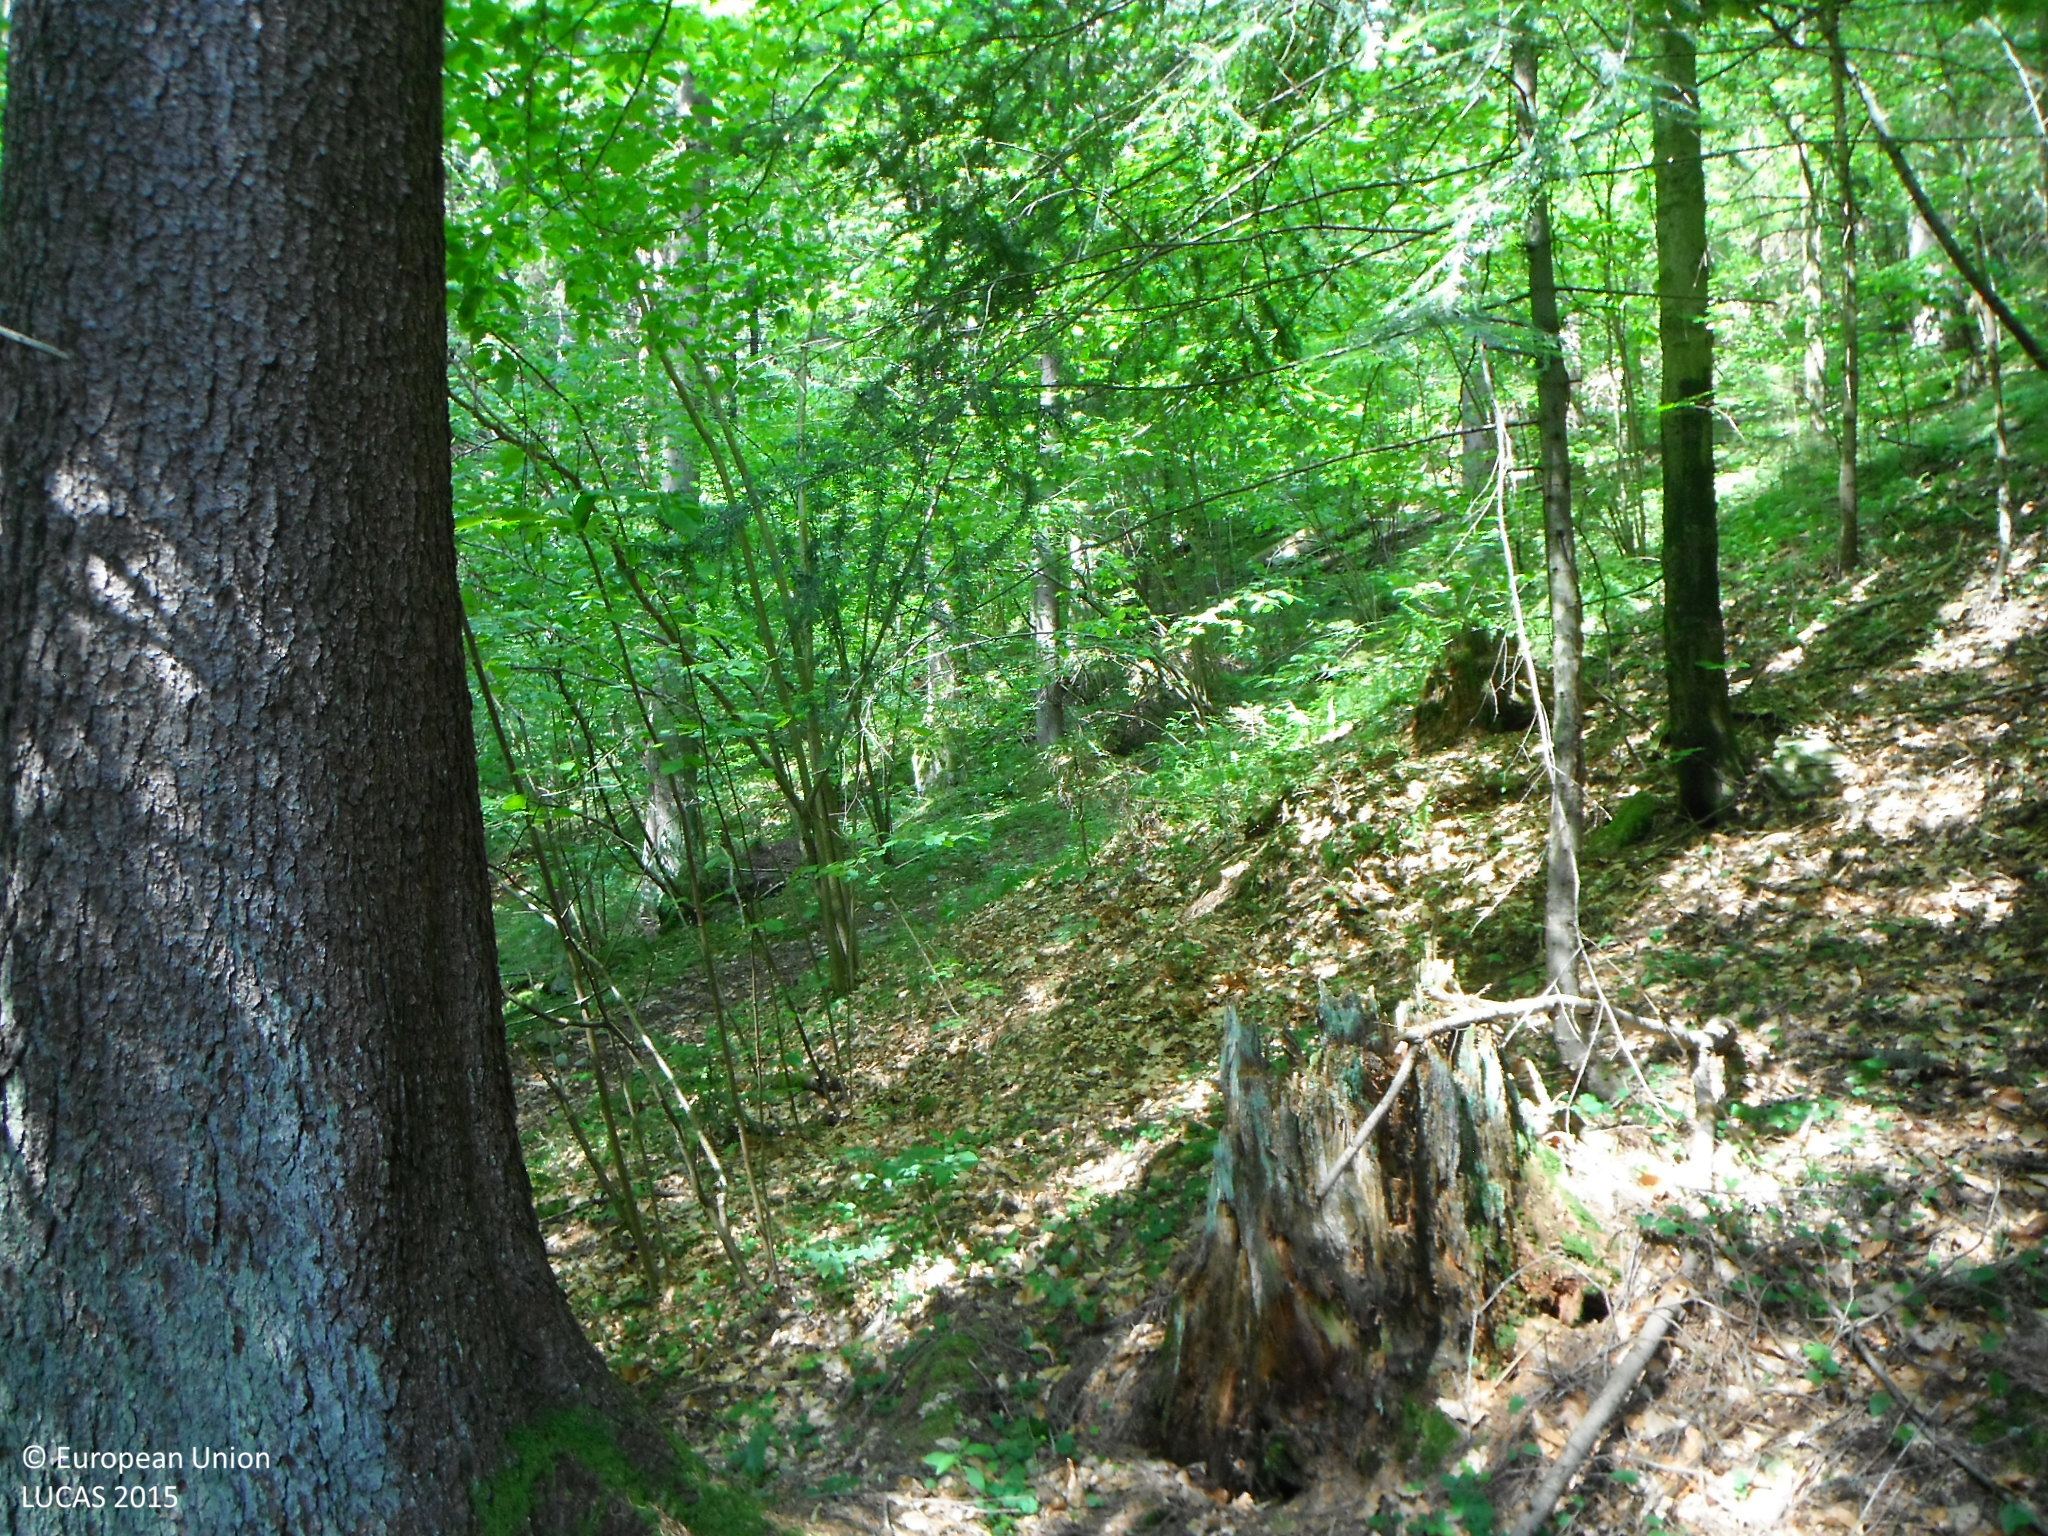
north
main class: Woodland
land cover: Spruce dominated coniferous woodland
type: alpine coniferous forest
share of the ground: > 75 %
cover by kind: coniferous forest trees 90 %, broadleaved forest trees 10 %
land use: Forestry
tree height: > 5 m
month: June
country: SK
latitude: 48.7826
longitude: 19.5939
